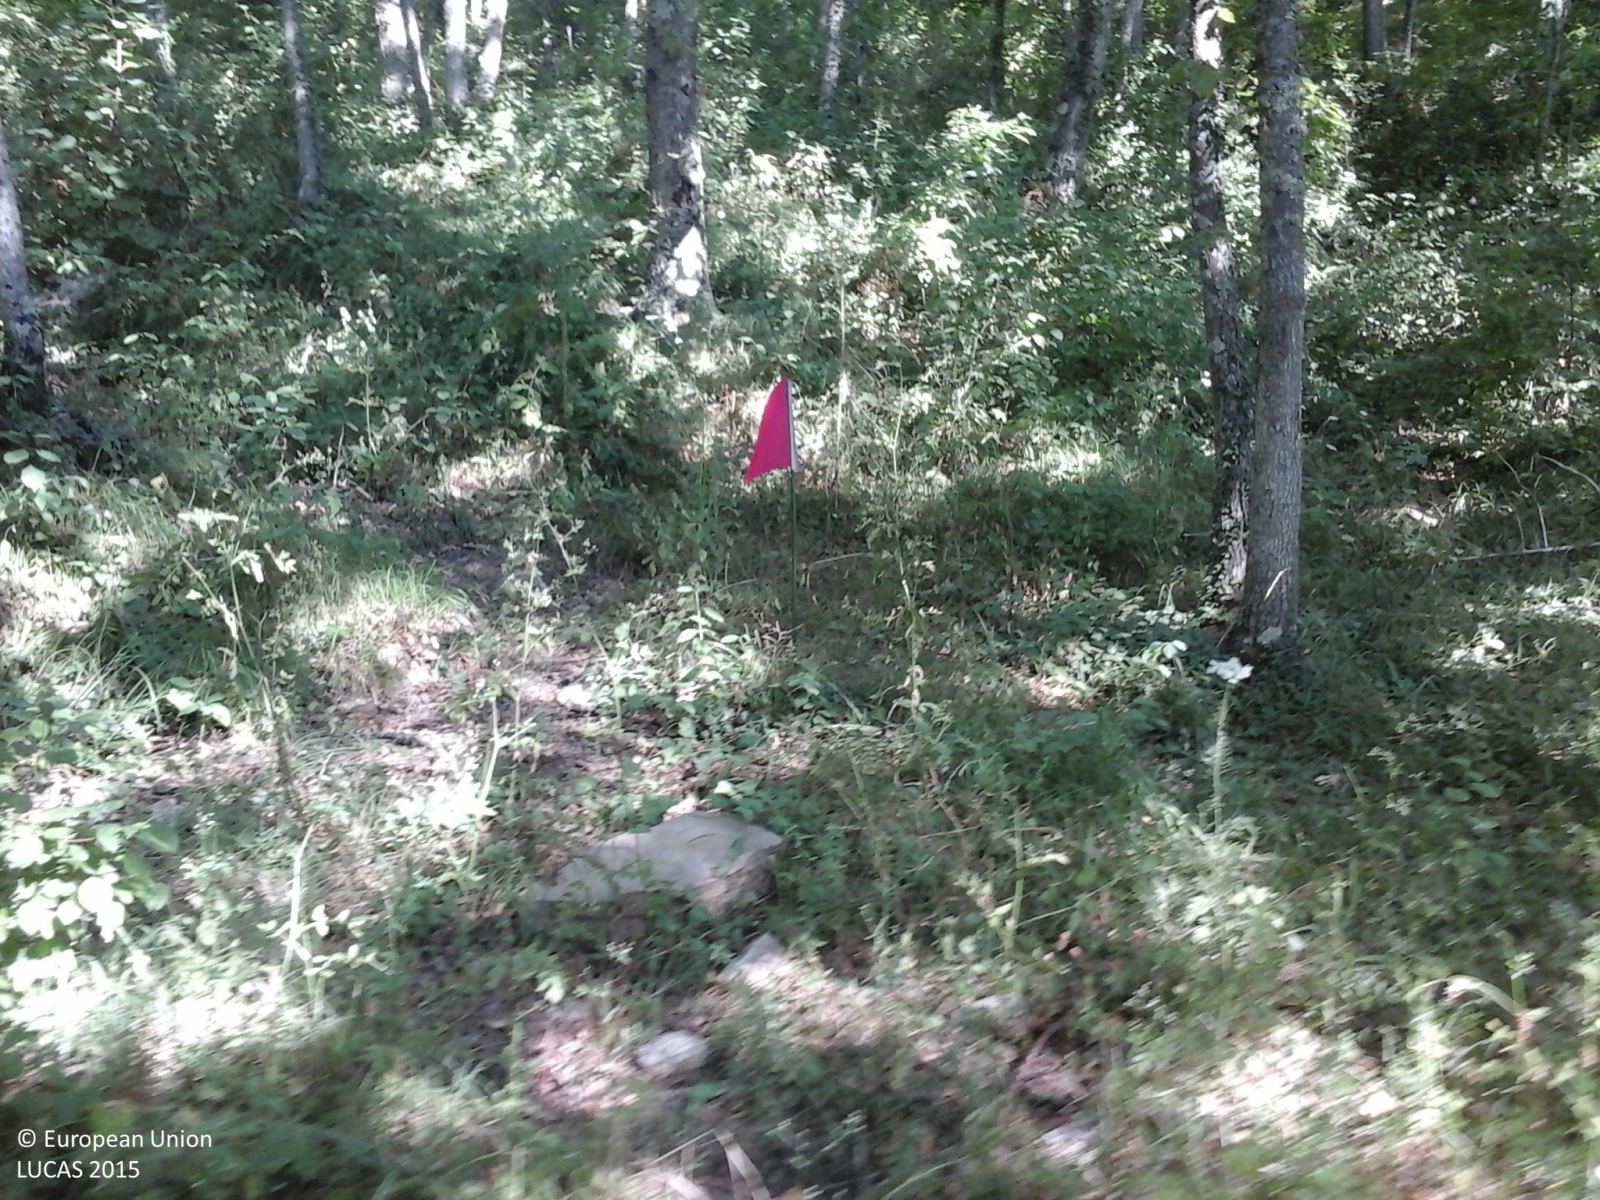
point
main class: Woodland
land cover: Broadleaved woodland
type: thermophilous deciduous forest
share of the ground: > 75 %
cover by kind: broadleaved forest trees 100 %
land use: Forestry
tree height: > 5 m
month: August
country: IT
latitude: 43.4558
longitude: 12.4282
